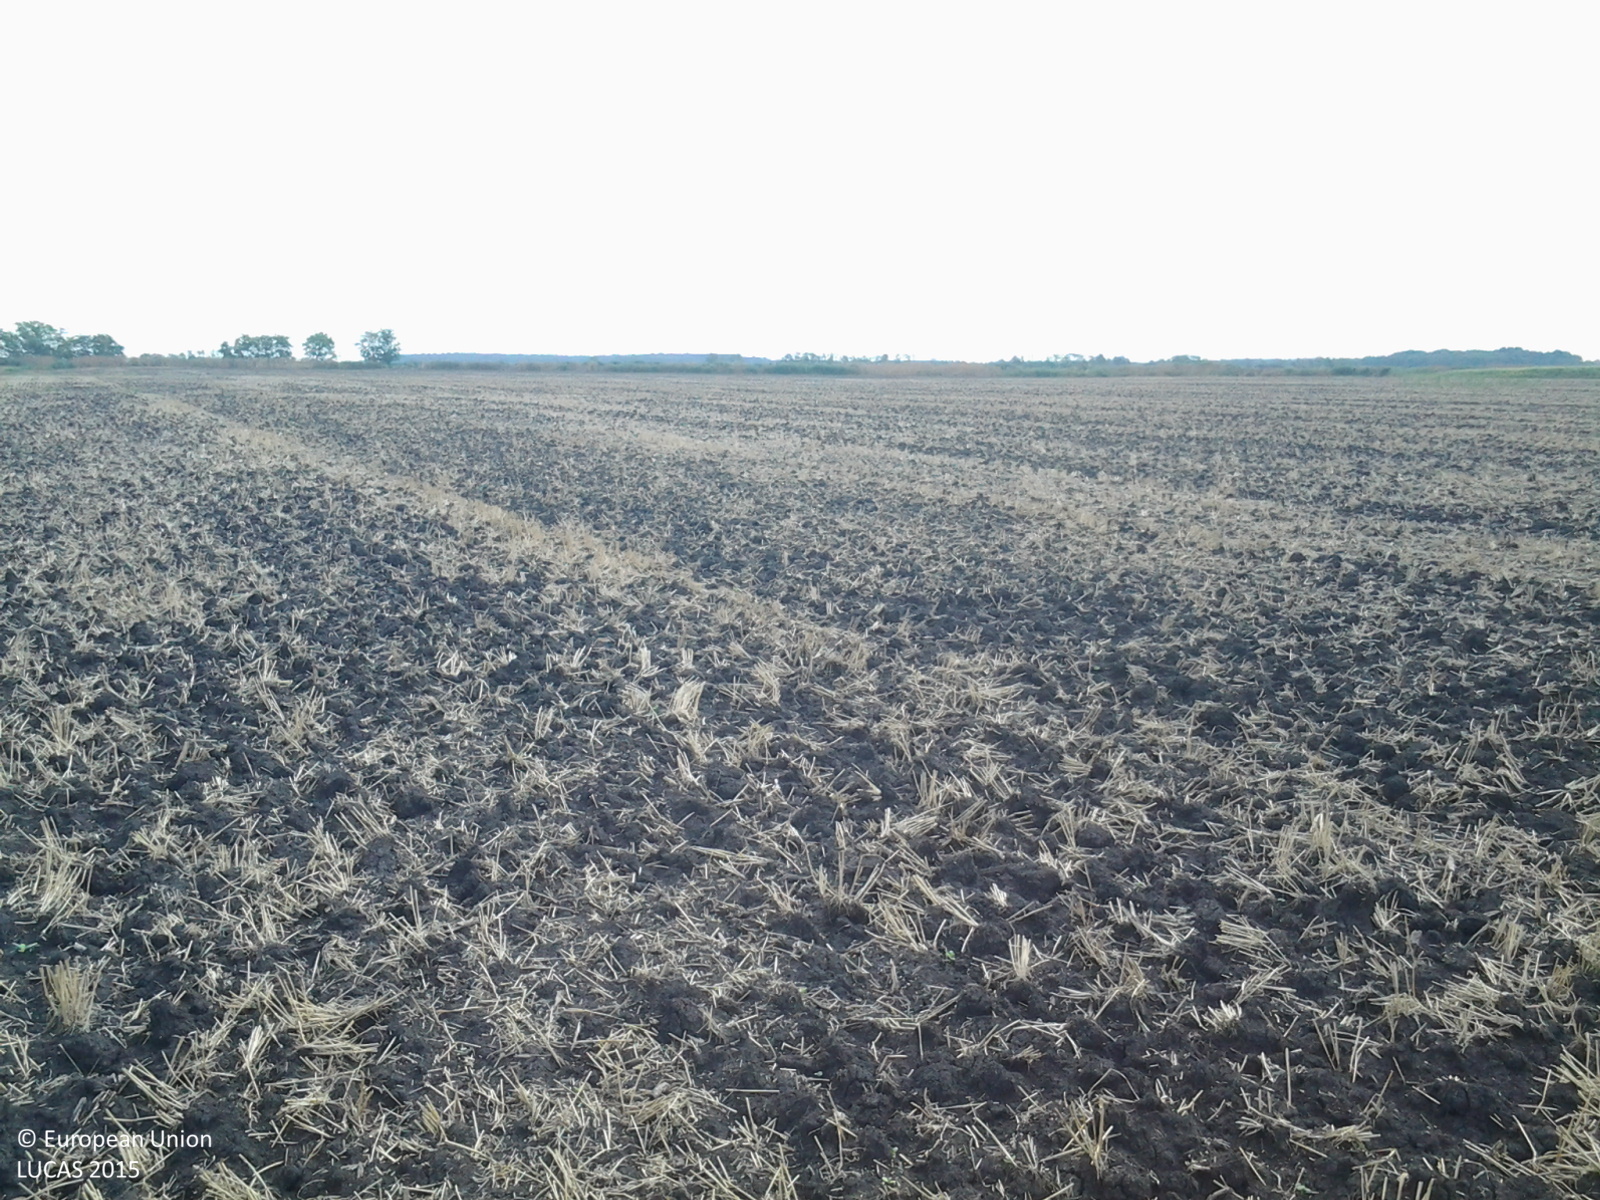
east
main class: Cropland
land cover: Common wheat
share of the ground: < 10 %
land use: Agriculture (excluding fallow land and kitchen gardens)
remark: Harvested field
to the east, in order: Common wheat
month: July
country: HU
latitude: 47.1361
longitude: 21.2581
